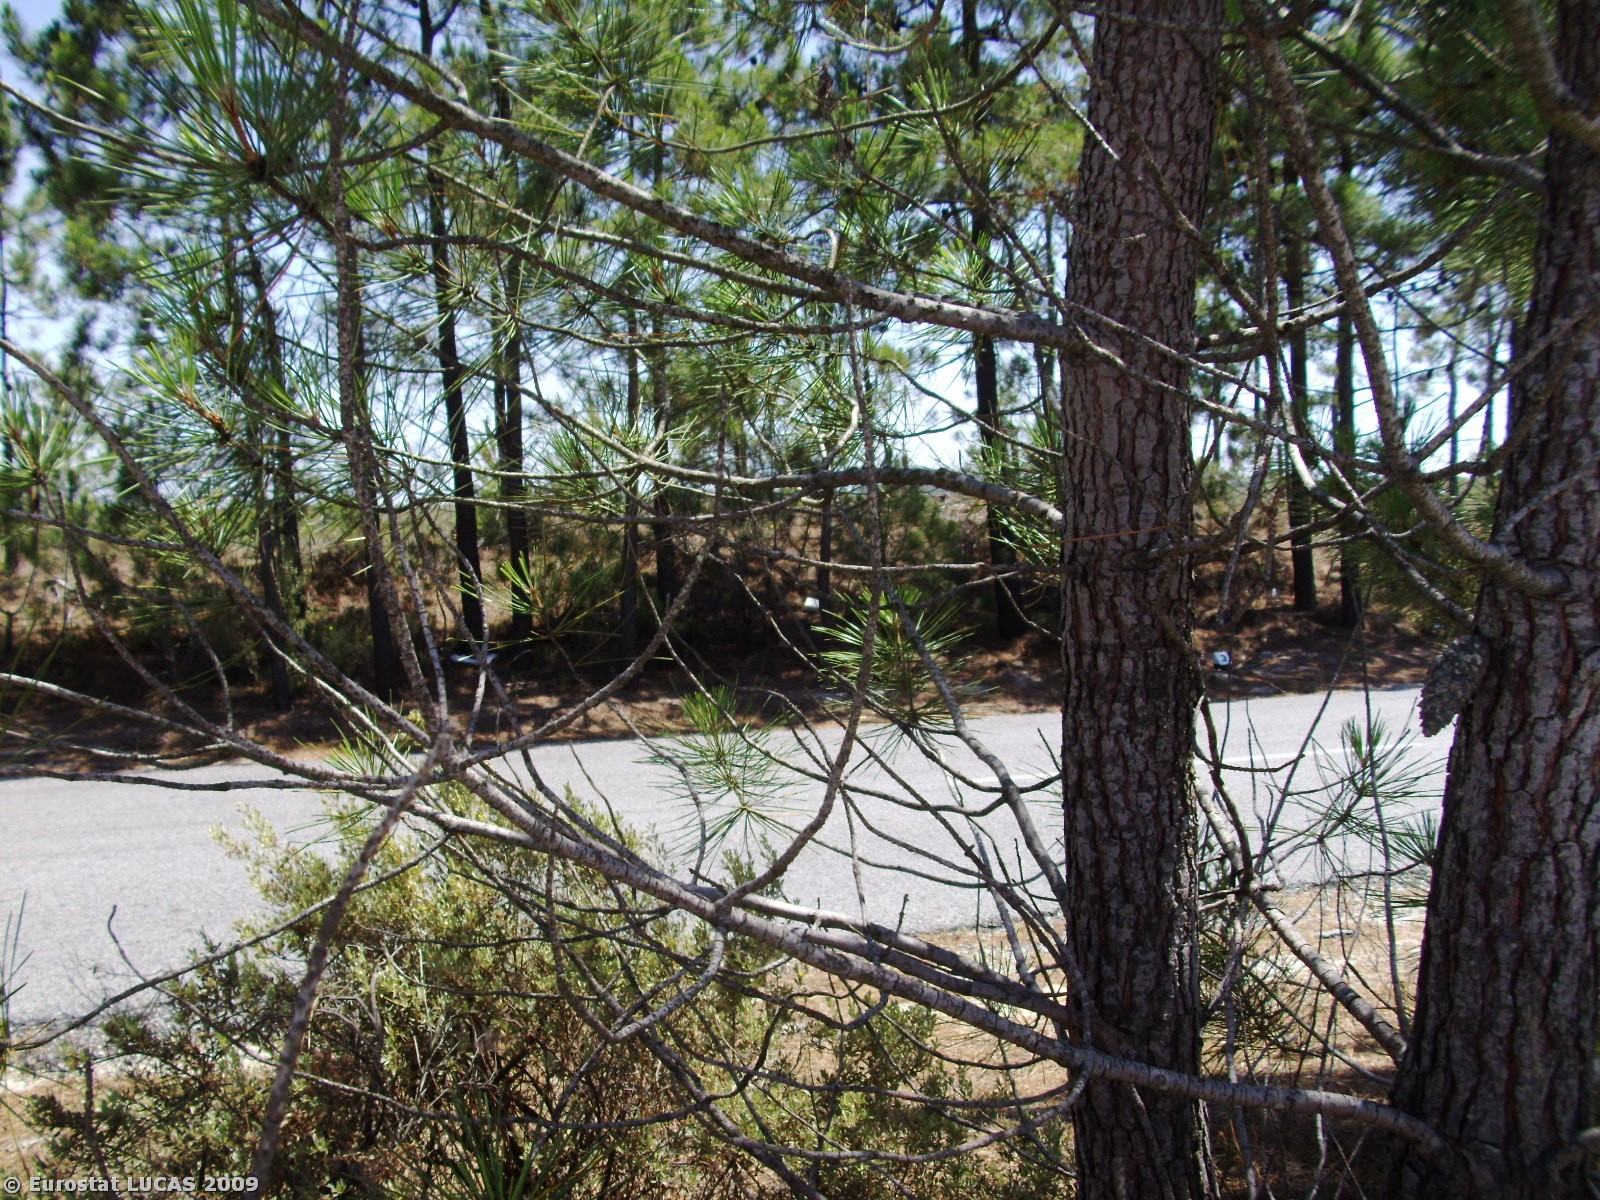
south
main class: Woodland
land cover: Coniferous woodland
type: coniferous forest of the mediterranean region
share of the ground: 25 - 50 %
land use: Forestry
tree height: > 5 m
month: June
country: PT
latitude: 38.3807
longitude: -8.7747
